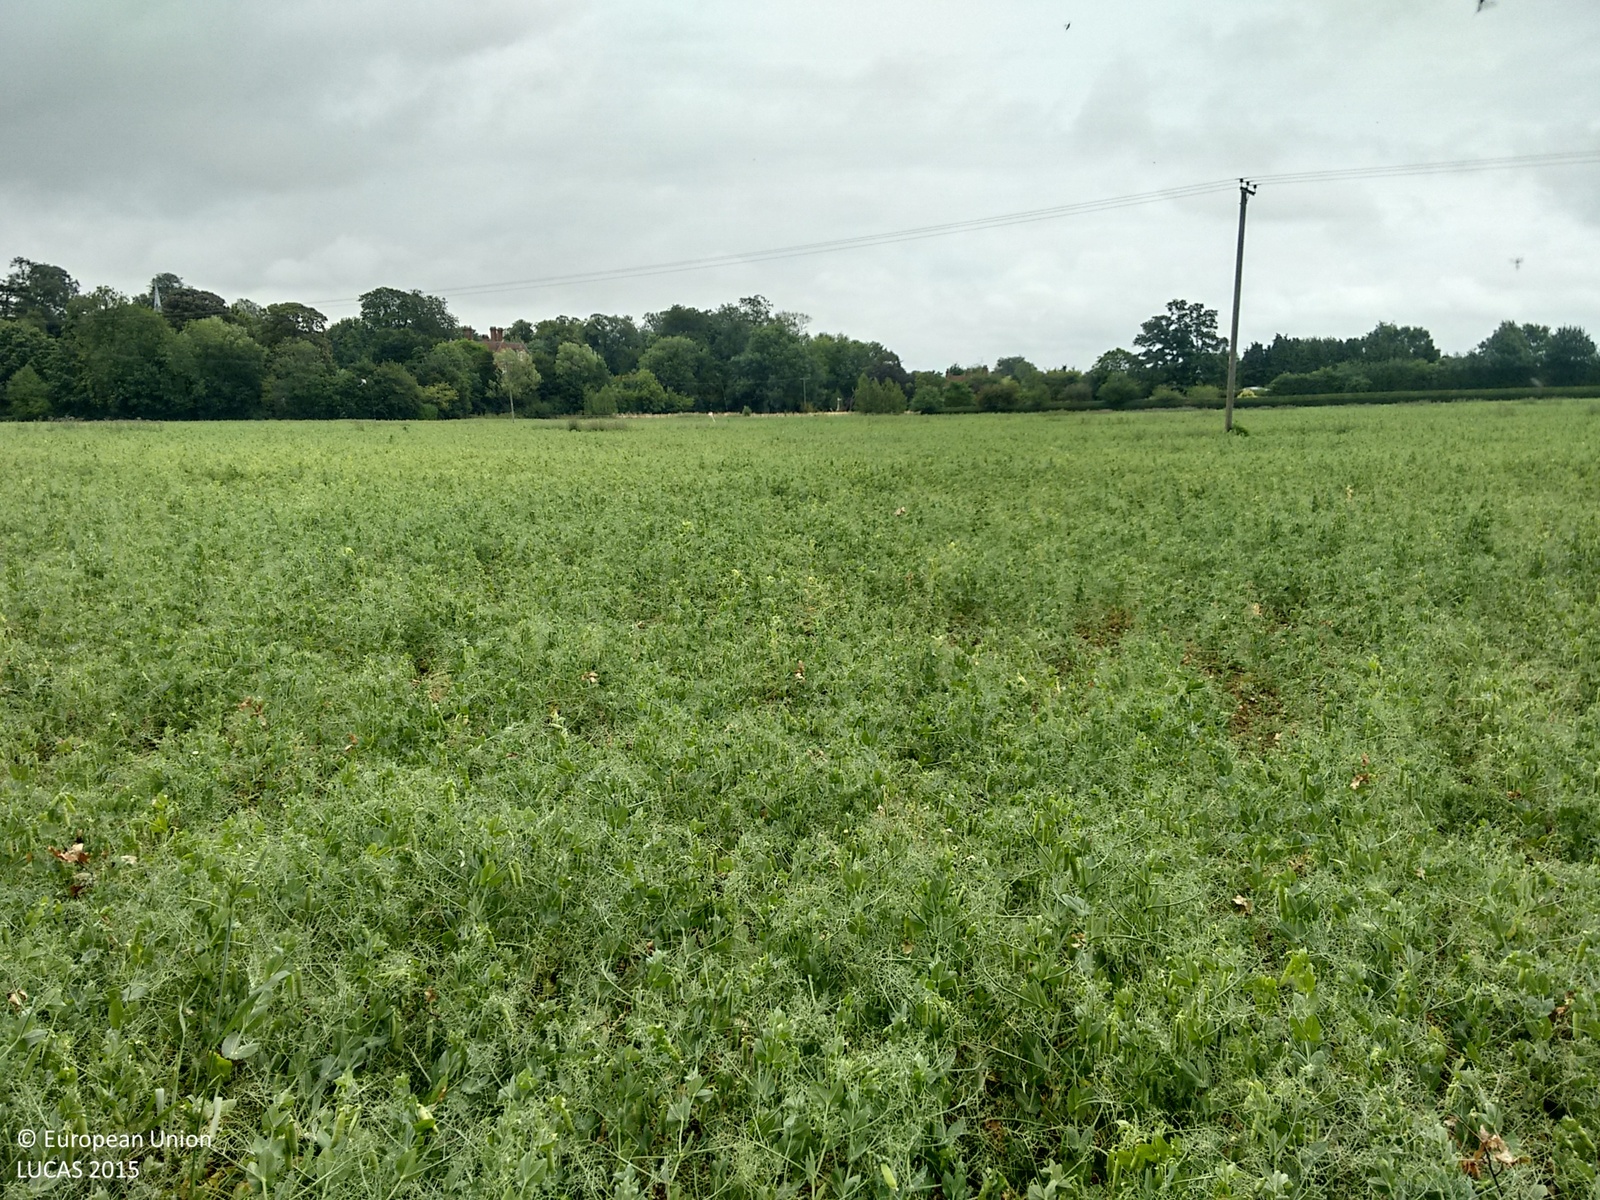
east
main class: Cropland
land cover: Dry pulses
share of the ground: > 75 %
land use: Agriculture (excluding fallow land and kitchen gardens)
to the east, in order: Dry pulses; Electric lines; Dry pulses; Grassland without tree/shrub cover; Tracks; Grassland without tree/shrub cover; Fences; Grassland without tree/shrub cover; Single bushes/trees; Artificial constructions in urban areas
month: July
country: GB
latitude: 51.7779
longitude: 0.2735
